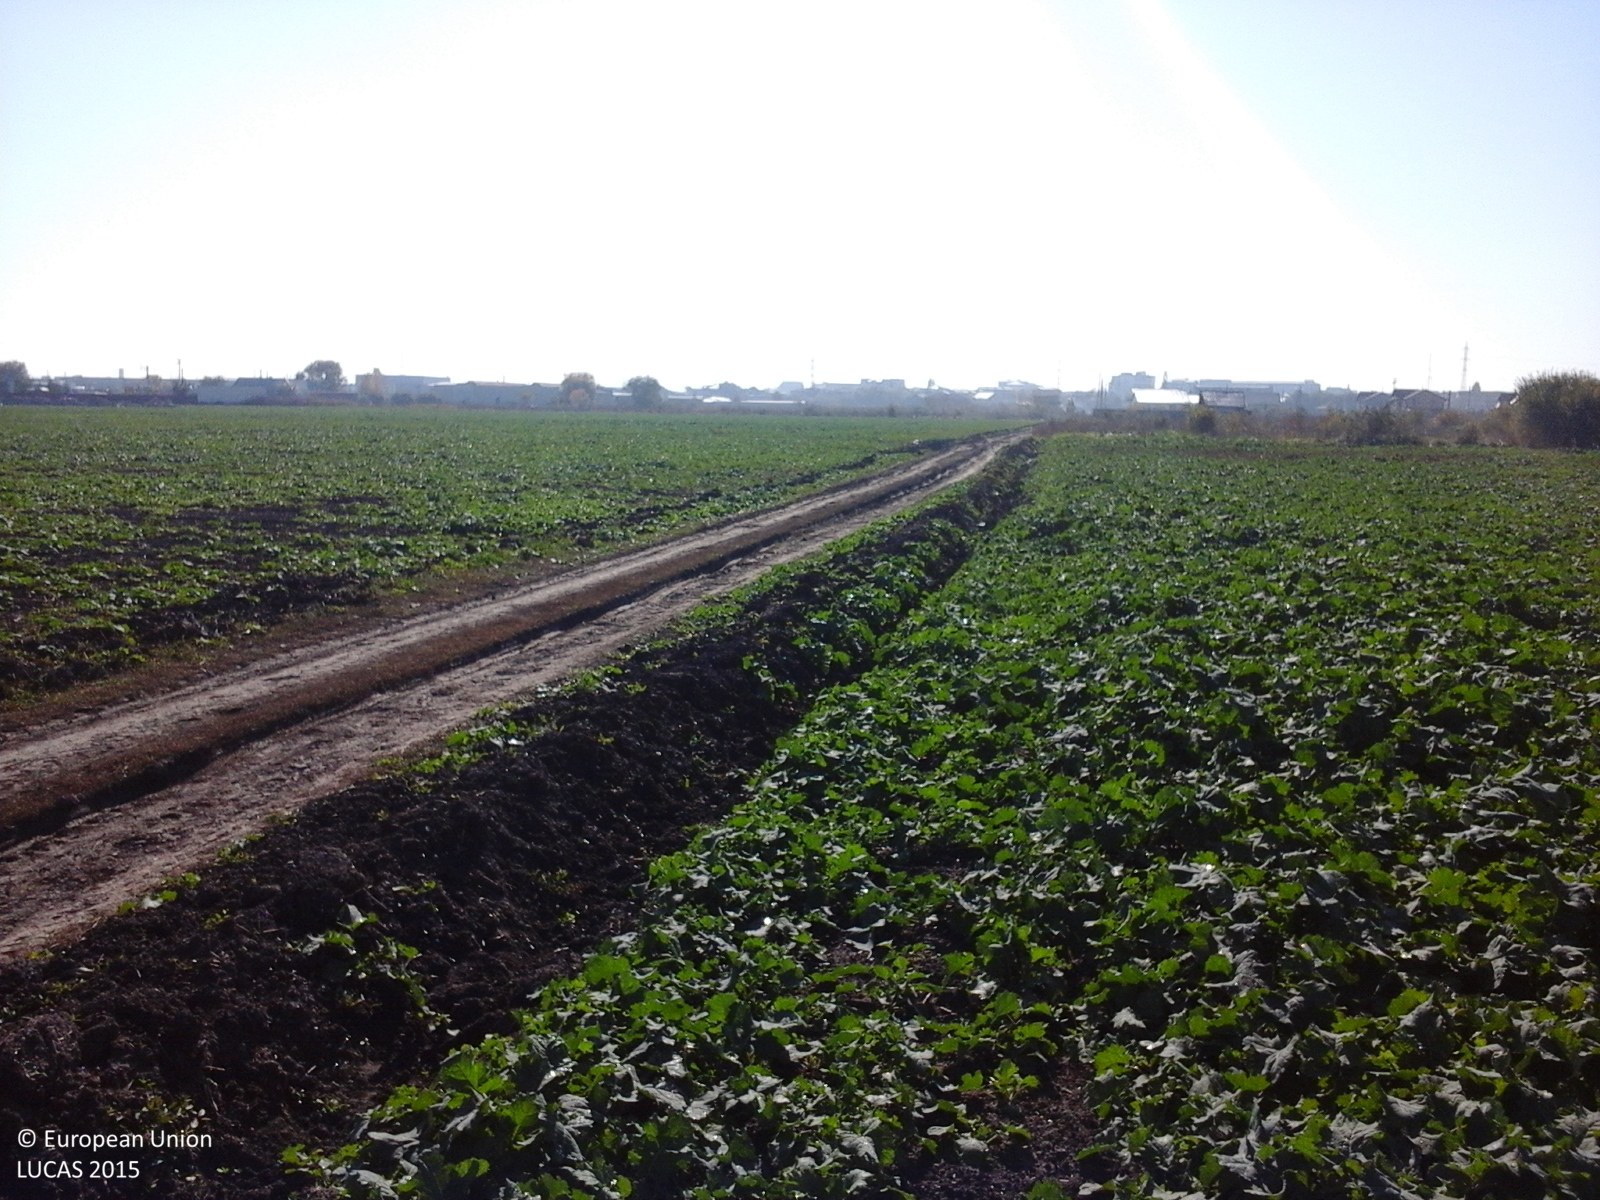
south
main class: Cropland
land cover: Rape and turnip rape
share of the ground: > 75 %
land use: Agriculture (excluding fallow land and kitchen gardens)
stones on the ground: < 10 %
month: October
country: RO
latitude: 45.7180
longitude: 27.1951
